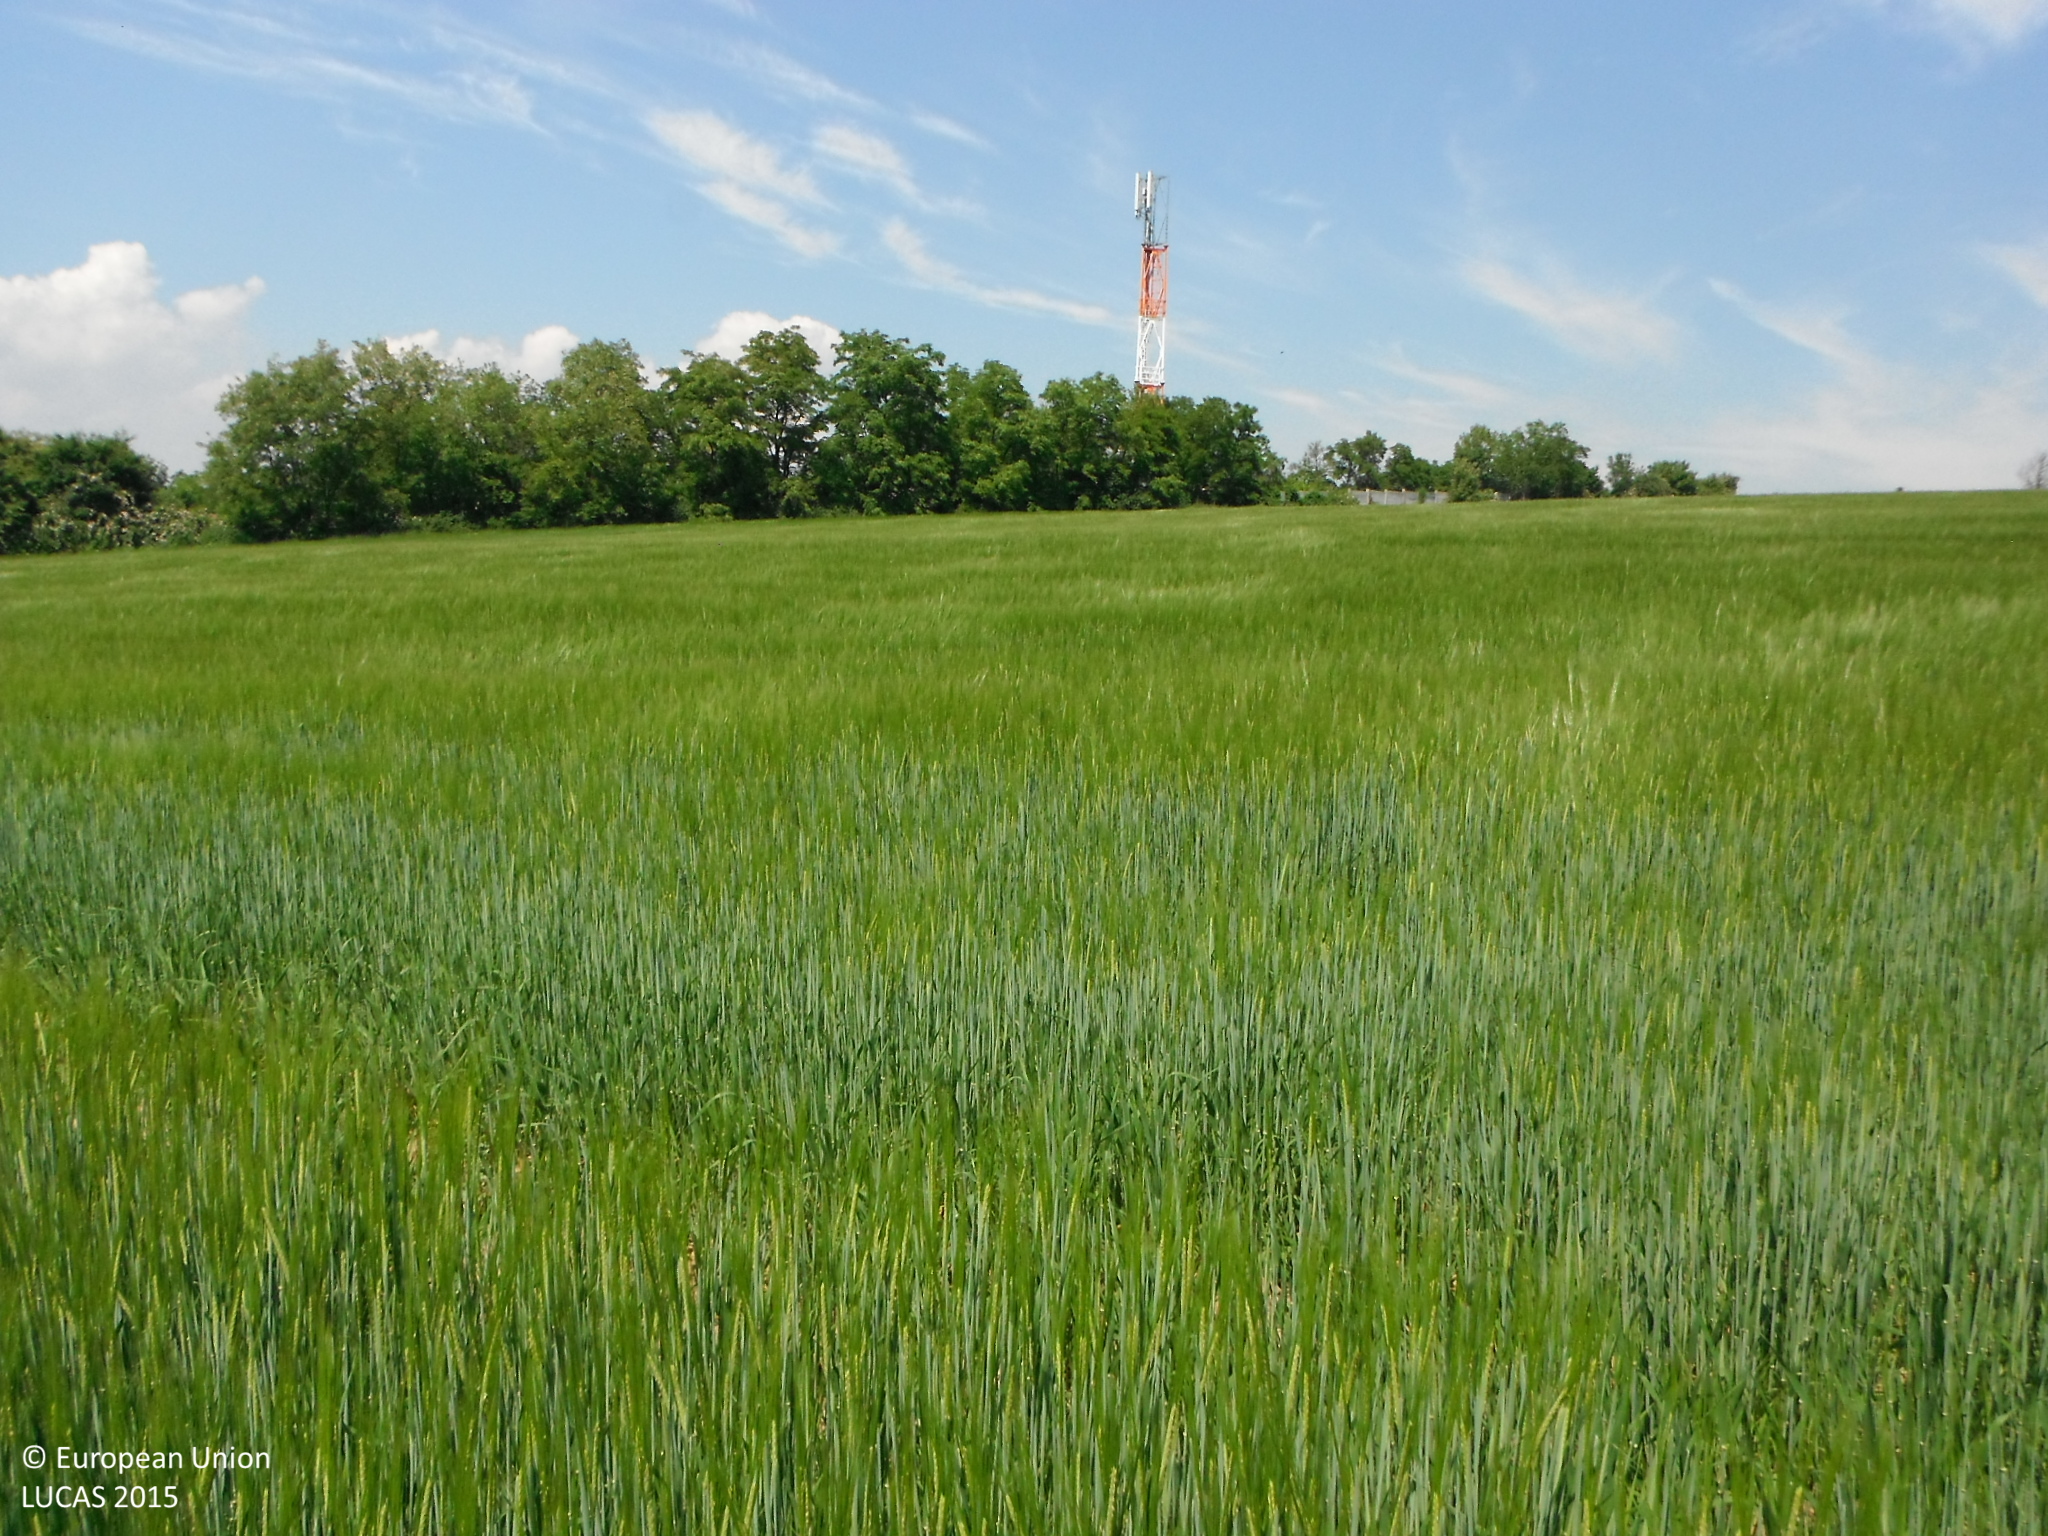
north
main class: Cropland
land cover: Barley
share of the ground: > 75 %
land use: Agriculture (excluding fallow land and kitchen gardens)
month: June
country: SK
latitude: 48.3529
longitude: 17.4185
